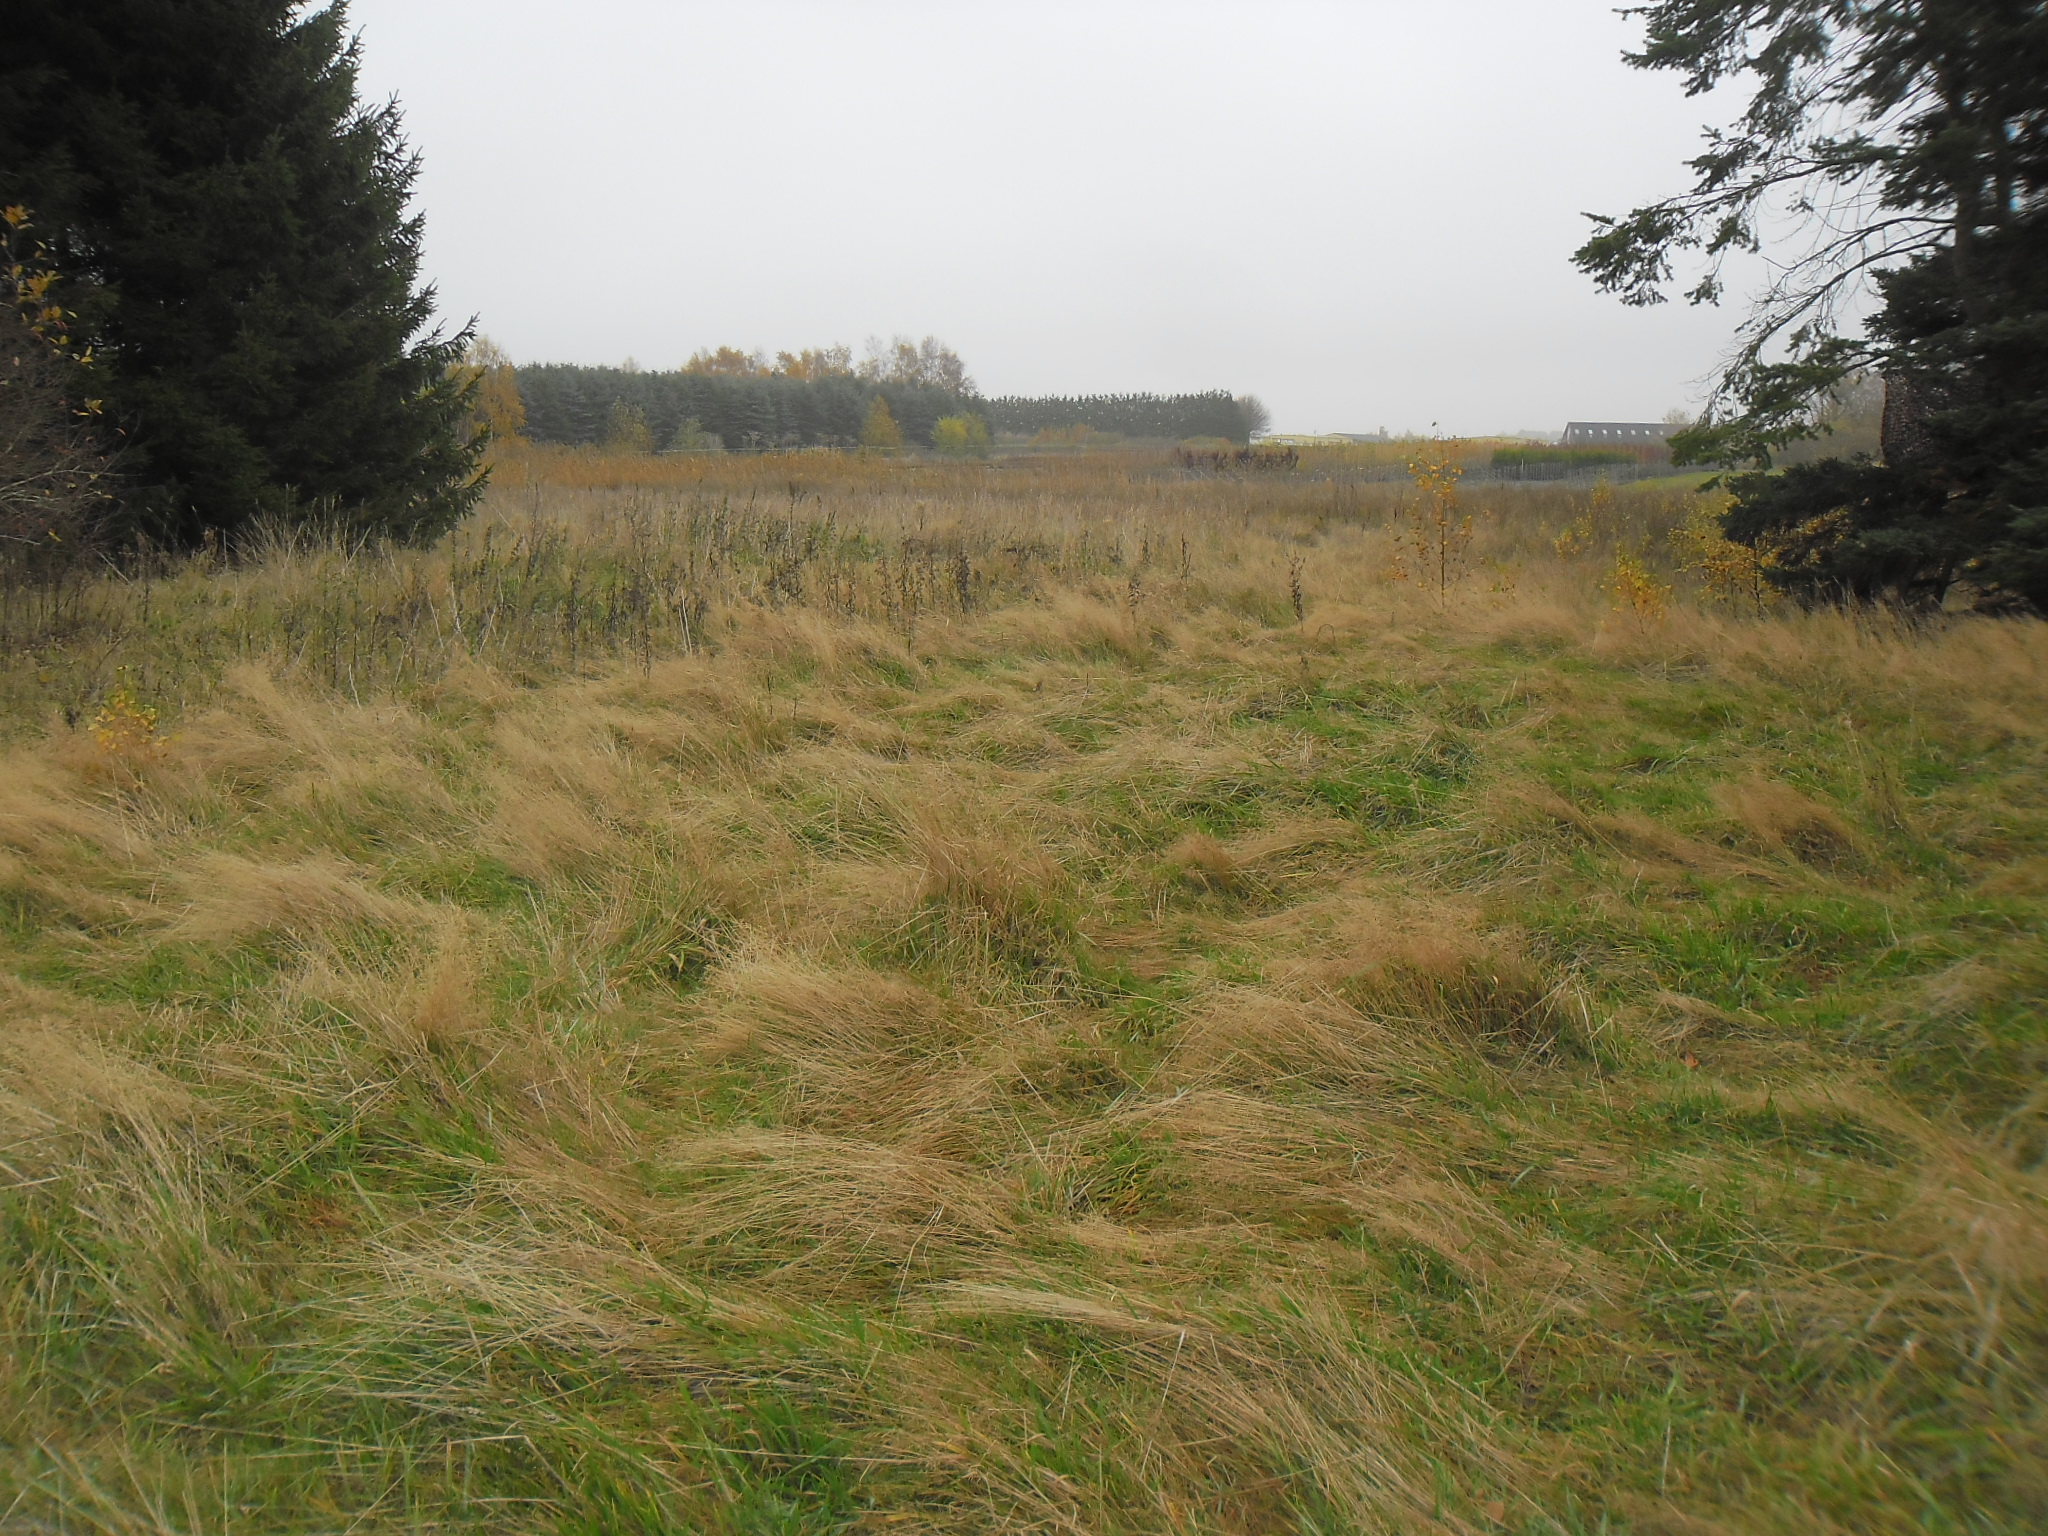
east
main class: Grassland
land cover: Grassland without tree/shrub cover
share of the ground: > 75 %
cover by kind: herbaceous plants 100 %
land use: Agriculture (excluding fallow land and kitchen gardens)
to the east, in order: Grassland without tree/shrub cover; Spontaneously vegetated surfaces; Nurseries; Spruce dominated coniferous woodland; Broadleaved woodland; Fences; Grass margins; Tracks; Grass margins; Fences; Nurseries
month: November
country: SE
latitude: 56.2281
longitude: 12.8524
